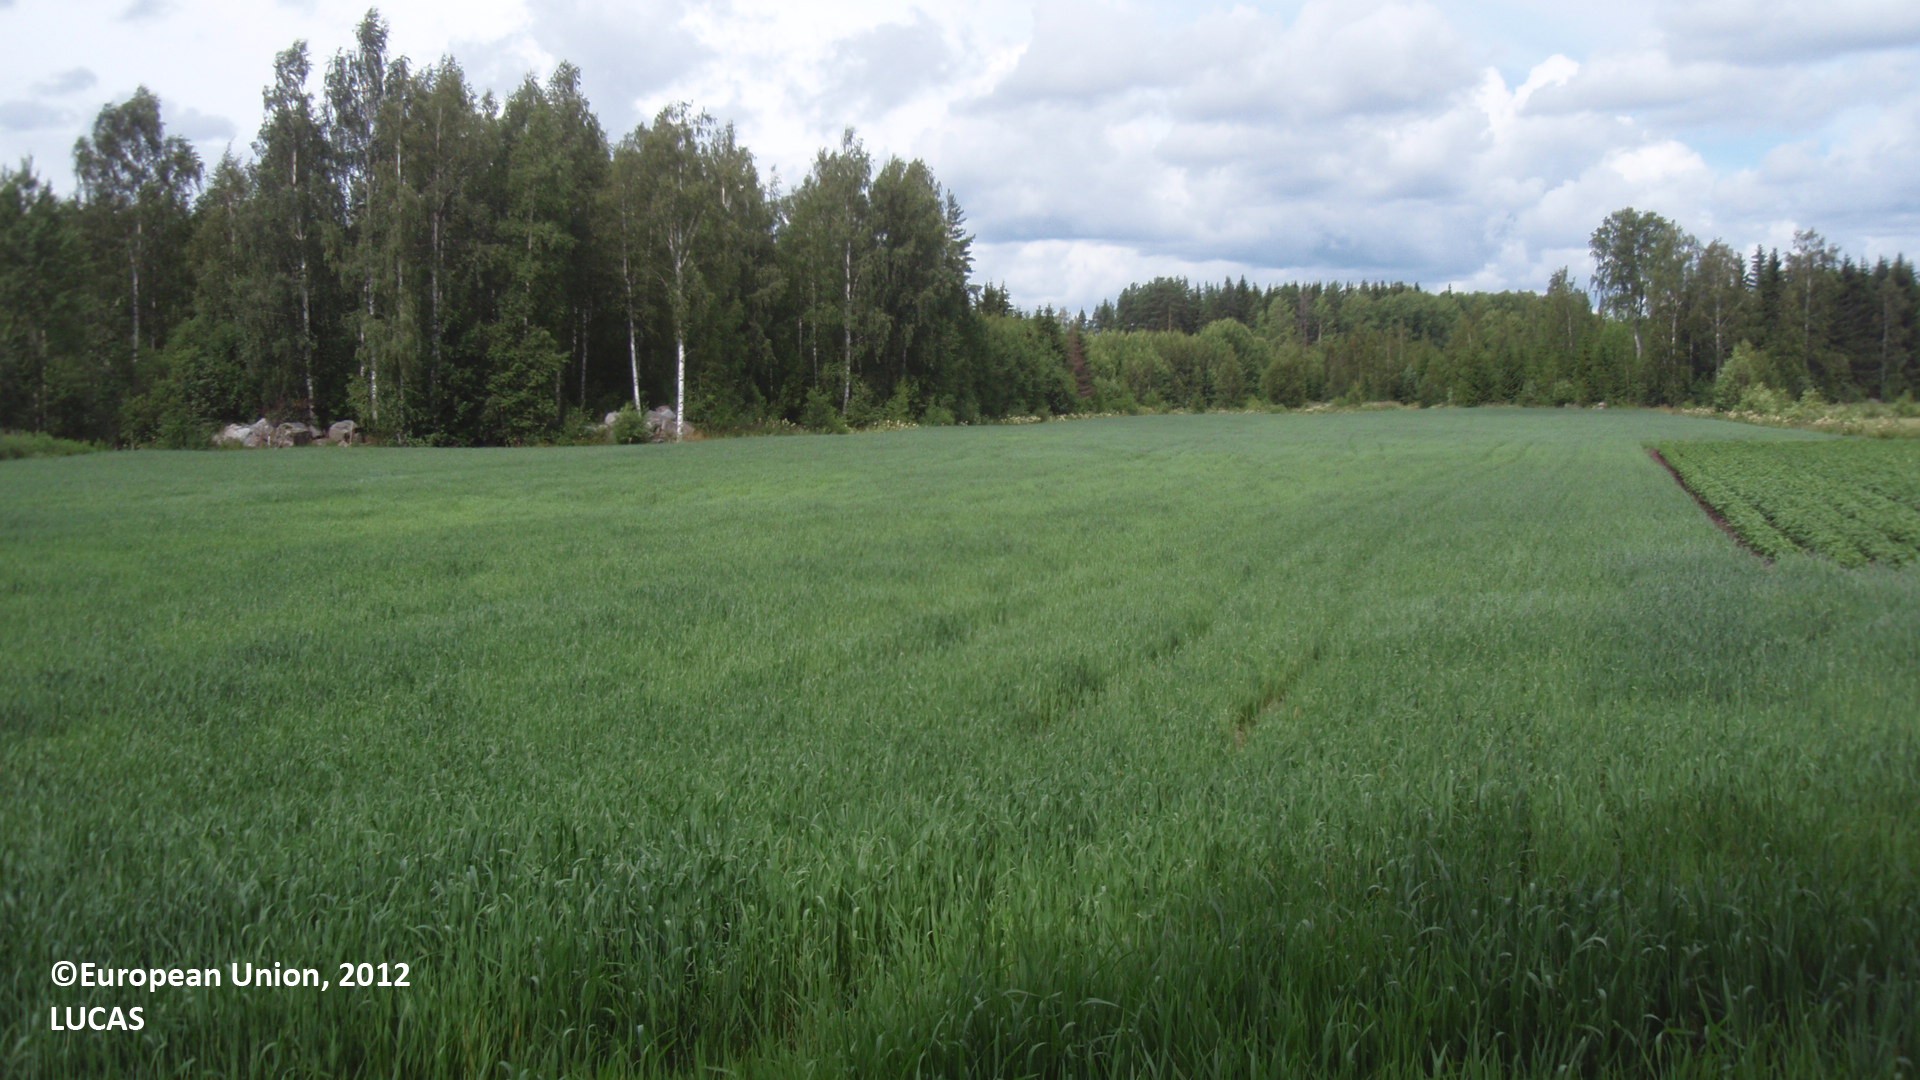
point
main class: Cropland
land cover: Oats
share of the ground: > 75 %
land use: Agriculture (excluding fallow land and kitchen gardens)
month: July
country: FI
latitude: 61.3169
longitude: 28.6537
